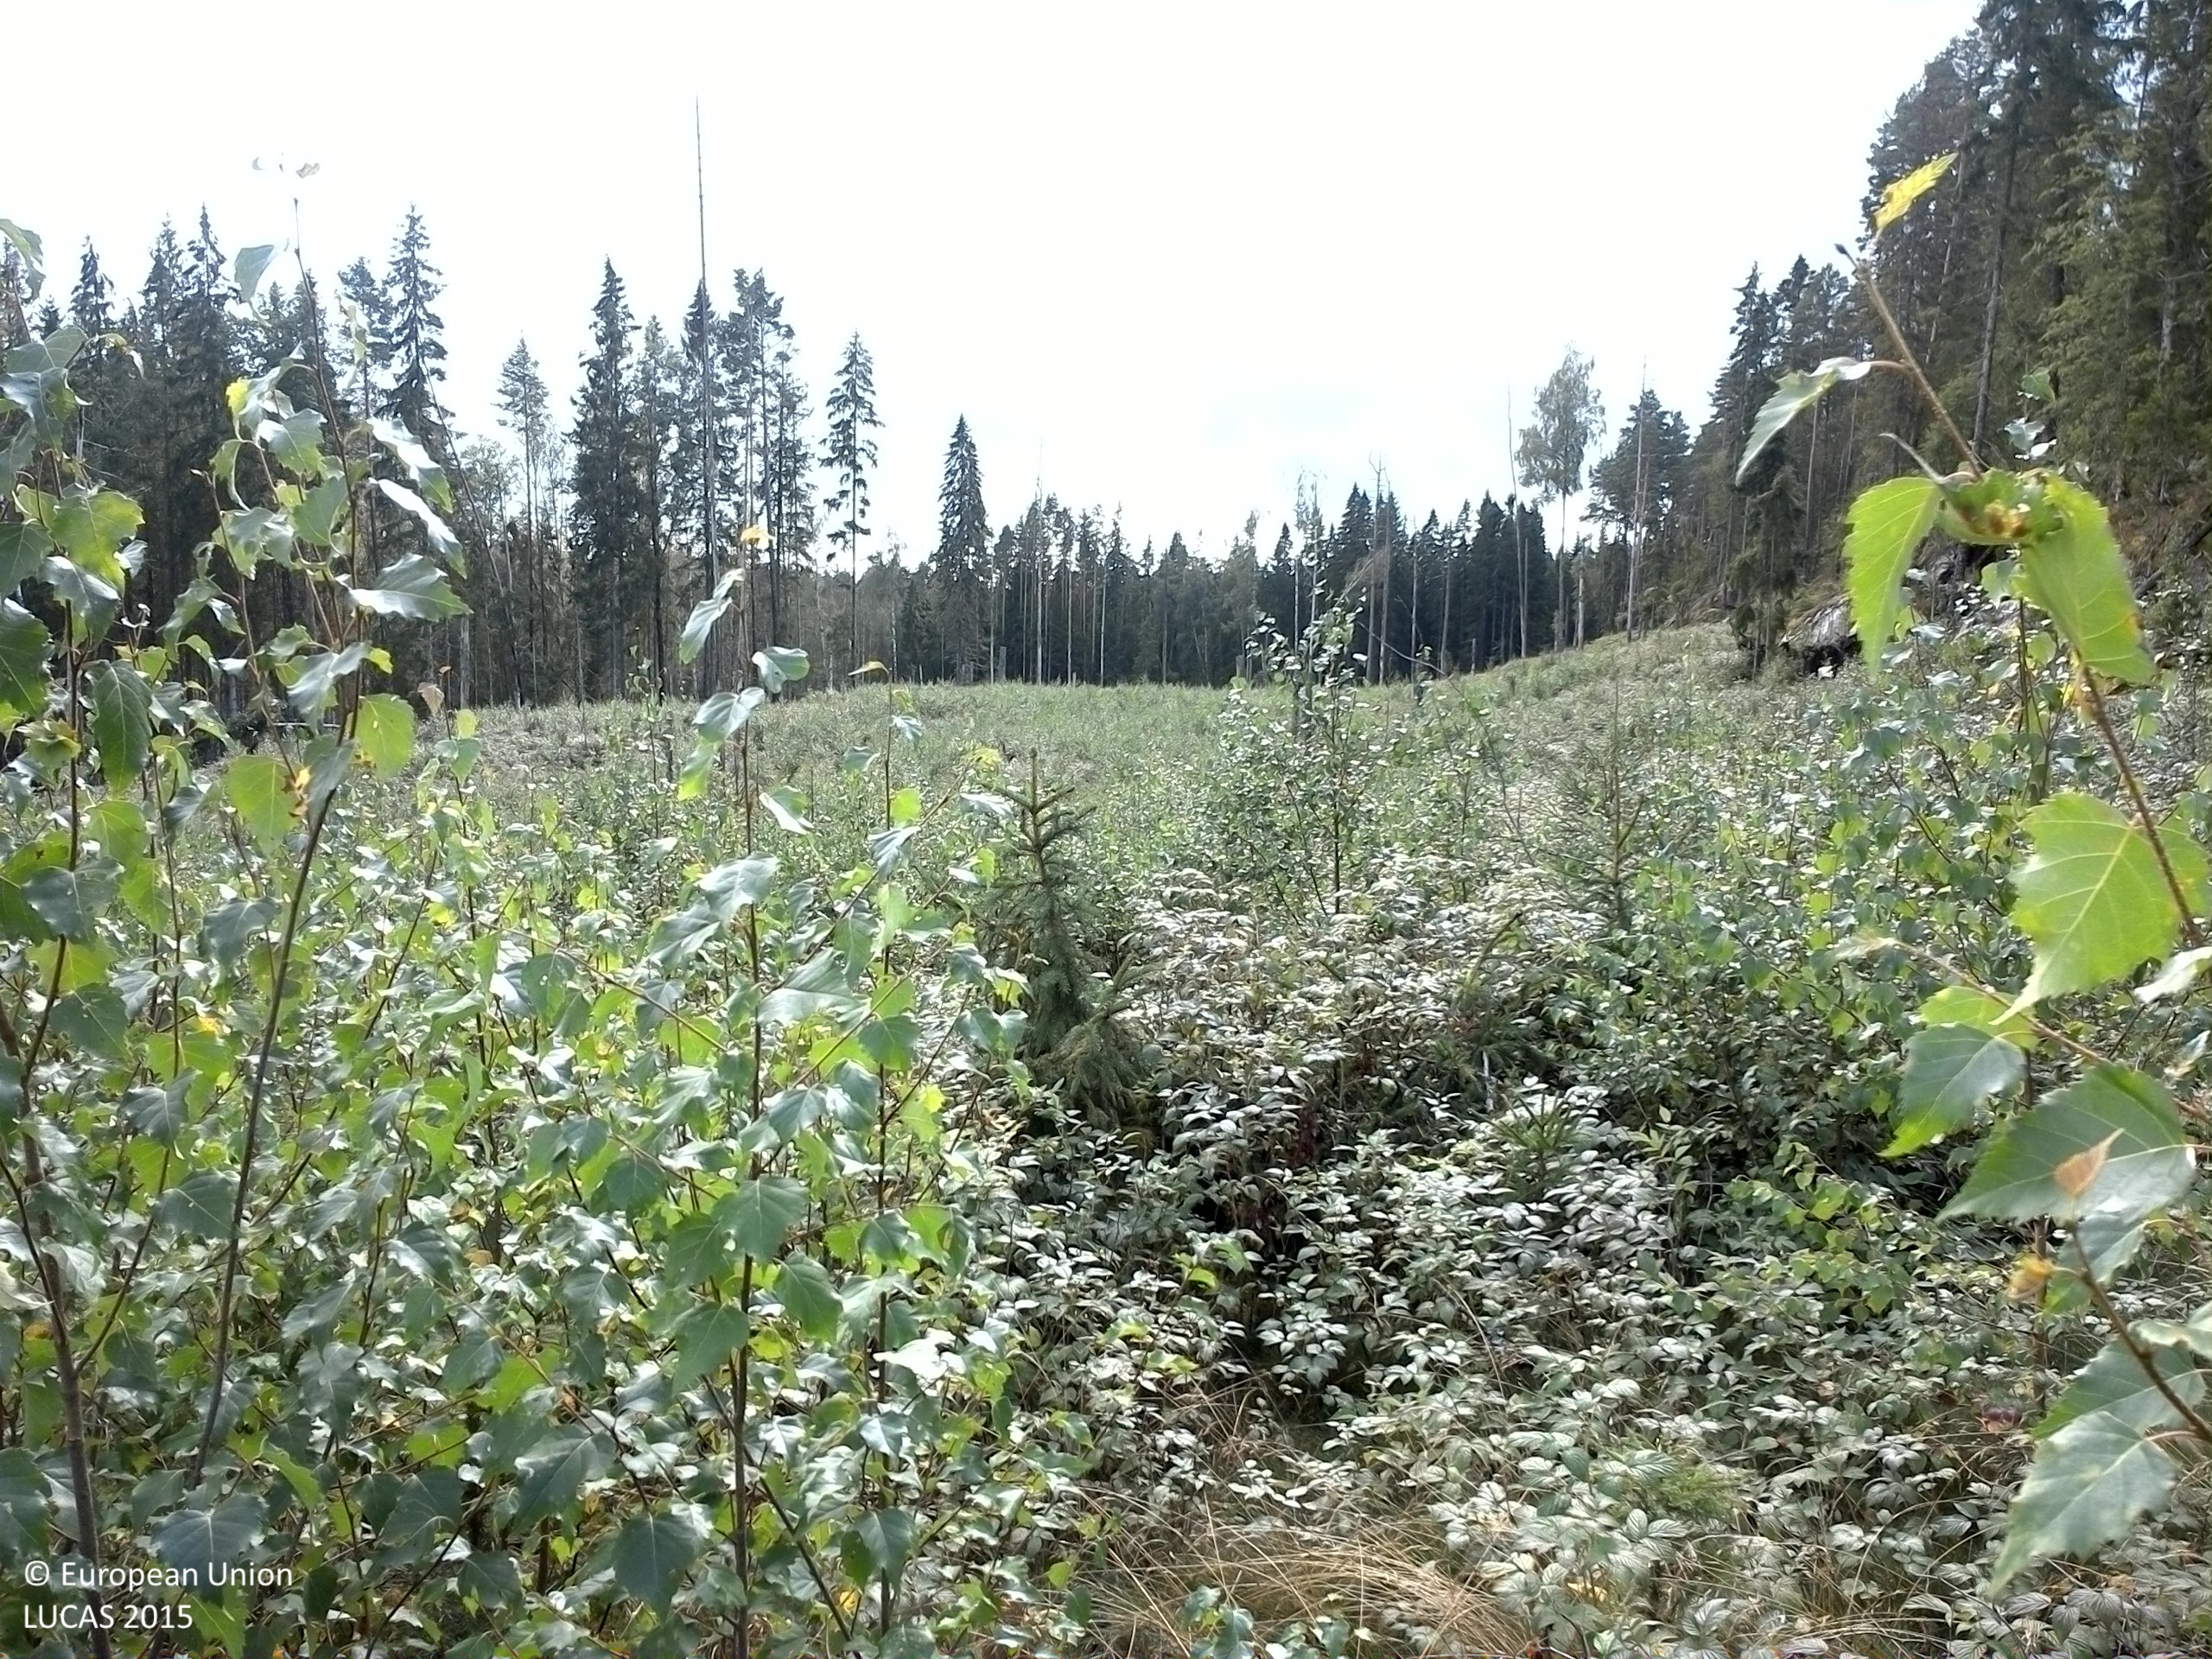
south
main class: Woodland
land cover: Spruce dominated mixed woodland
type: boreal forest
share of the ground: 25 - 50 %
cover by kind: broadleaved forest trees 30 %, shrubs 30 %, coniferous forest trees 20 %, herbaceous plants 10 %, consolidated bare surface 10 %
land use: Forestry
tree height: < 5 m
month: September
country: SE
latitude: 59.3206
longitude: 11.9805
